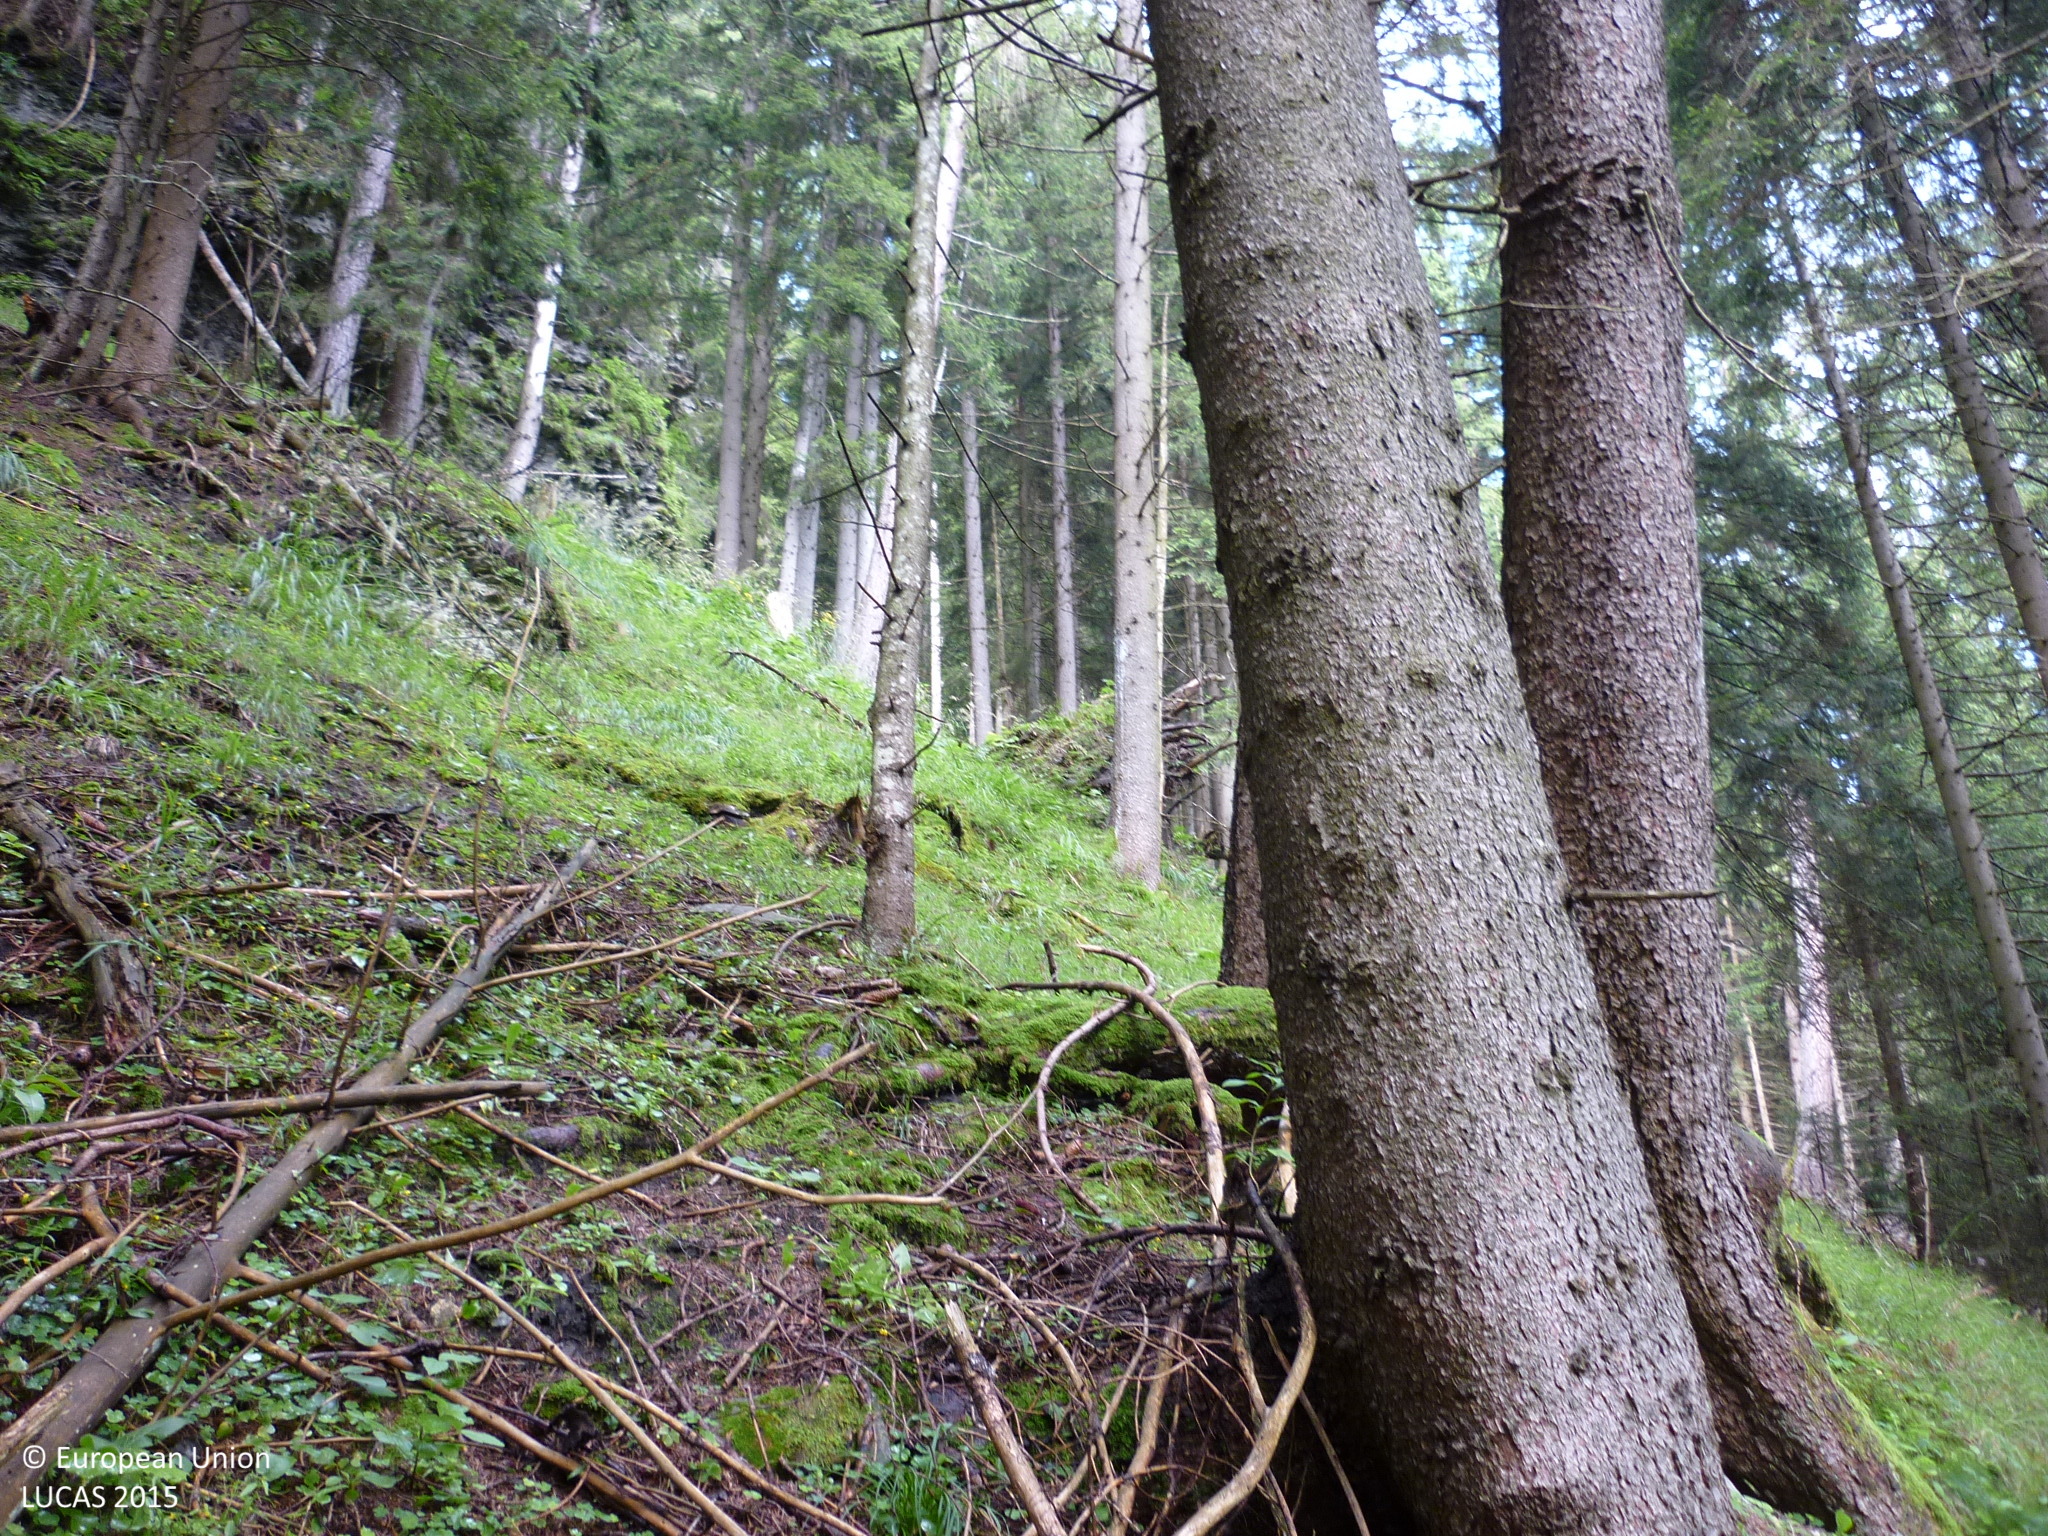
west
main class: Woodland
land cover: Spruce dominated coniferous woodland
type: alpine coniferous forest
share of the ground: > 75 %
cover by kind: coniferous forest trees 90 %, herbaceous plants 10 %
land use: Forestry
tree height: > 5 m
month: August
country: AT
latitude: 47.0300
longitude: 13.5900
